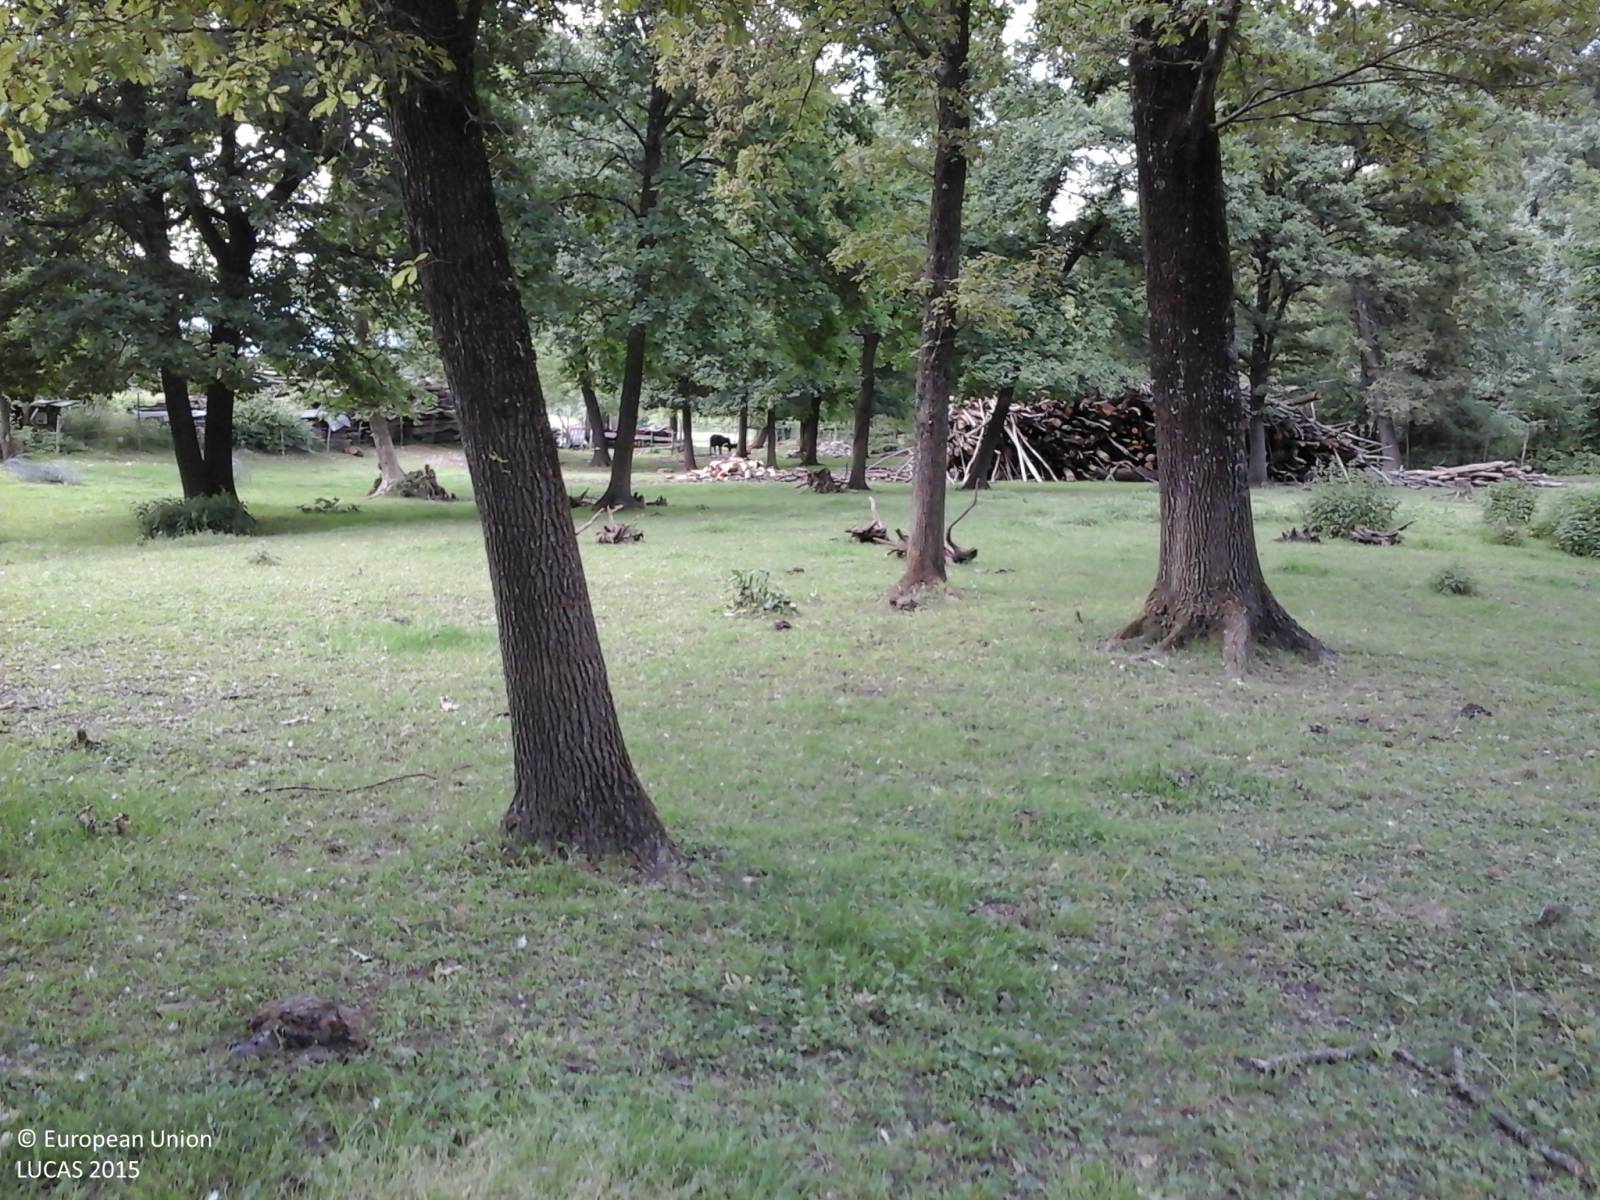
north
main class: Woodland
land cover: Broadleaved woodland
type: mesophytic deciduous forest
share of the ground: 50 - 75 %
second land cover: Grassland without tree/shrub cover
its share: > 75 %
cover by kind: broadleaved forest trees 60 %, herbaceous plants 40 %
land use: Forestry
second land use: Agriculture (excluding fallow land and kitchen gardens)
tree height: > 5 m
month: May
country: IT
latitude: 46.1561
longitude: 13.2985
